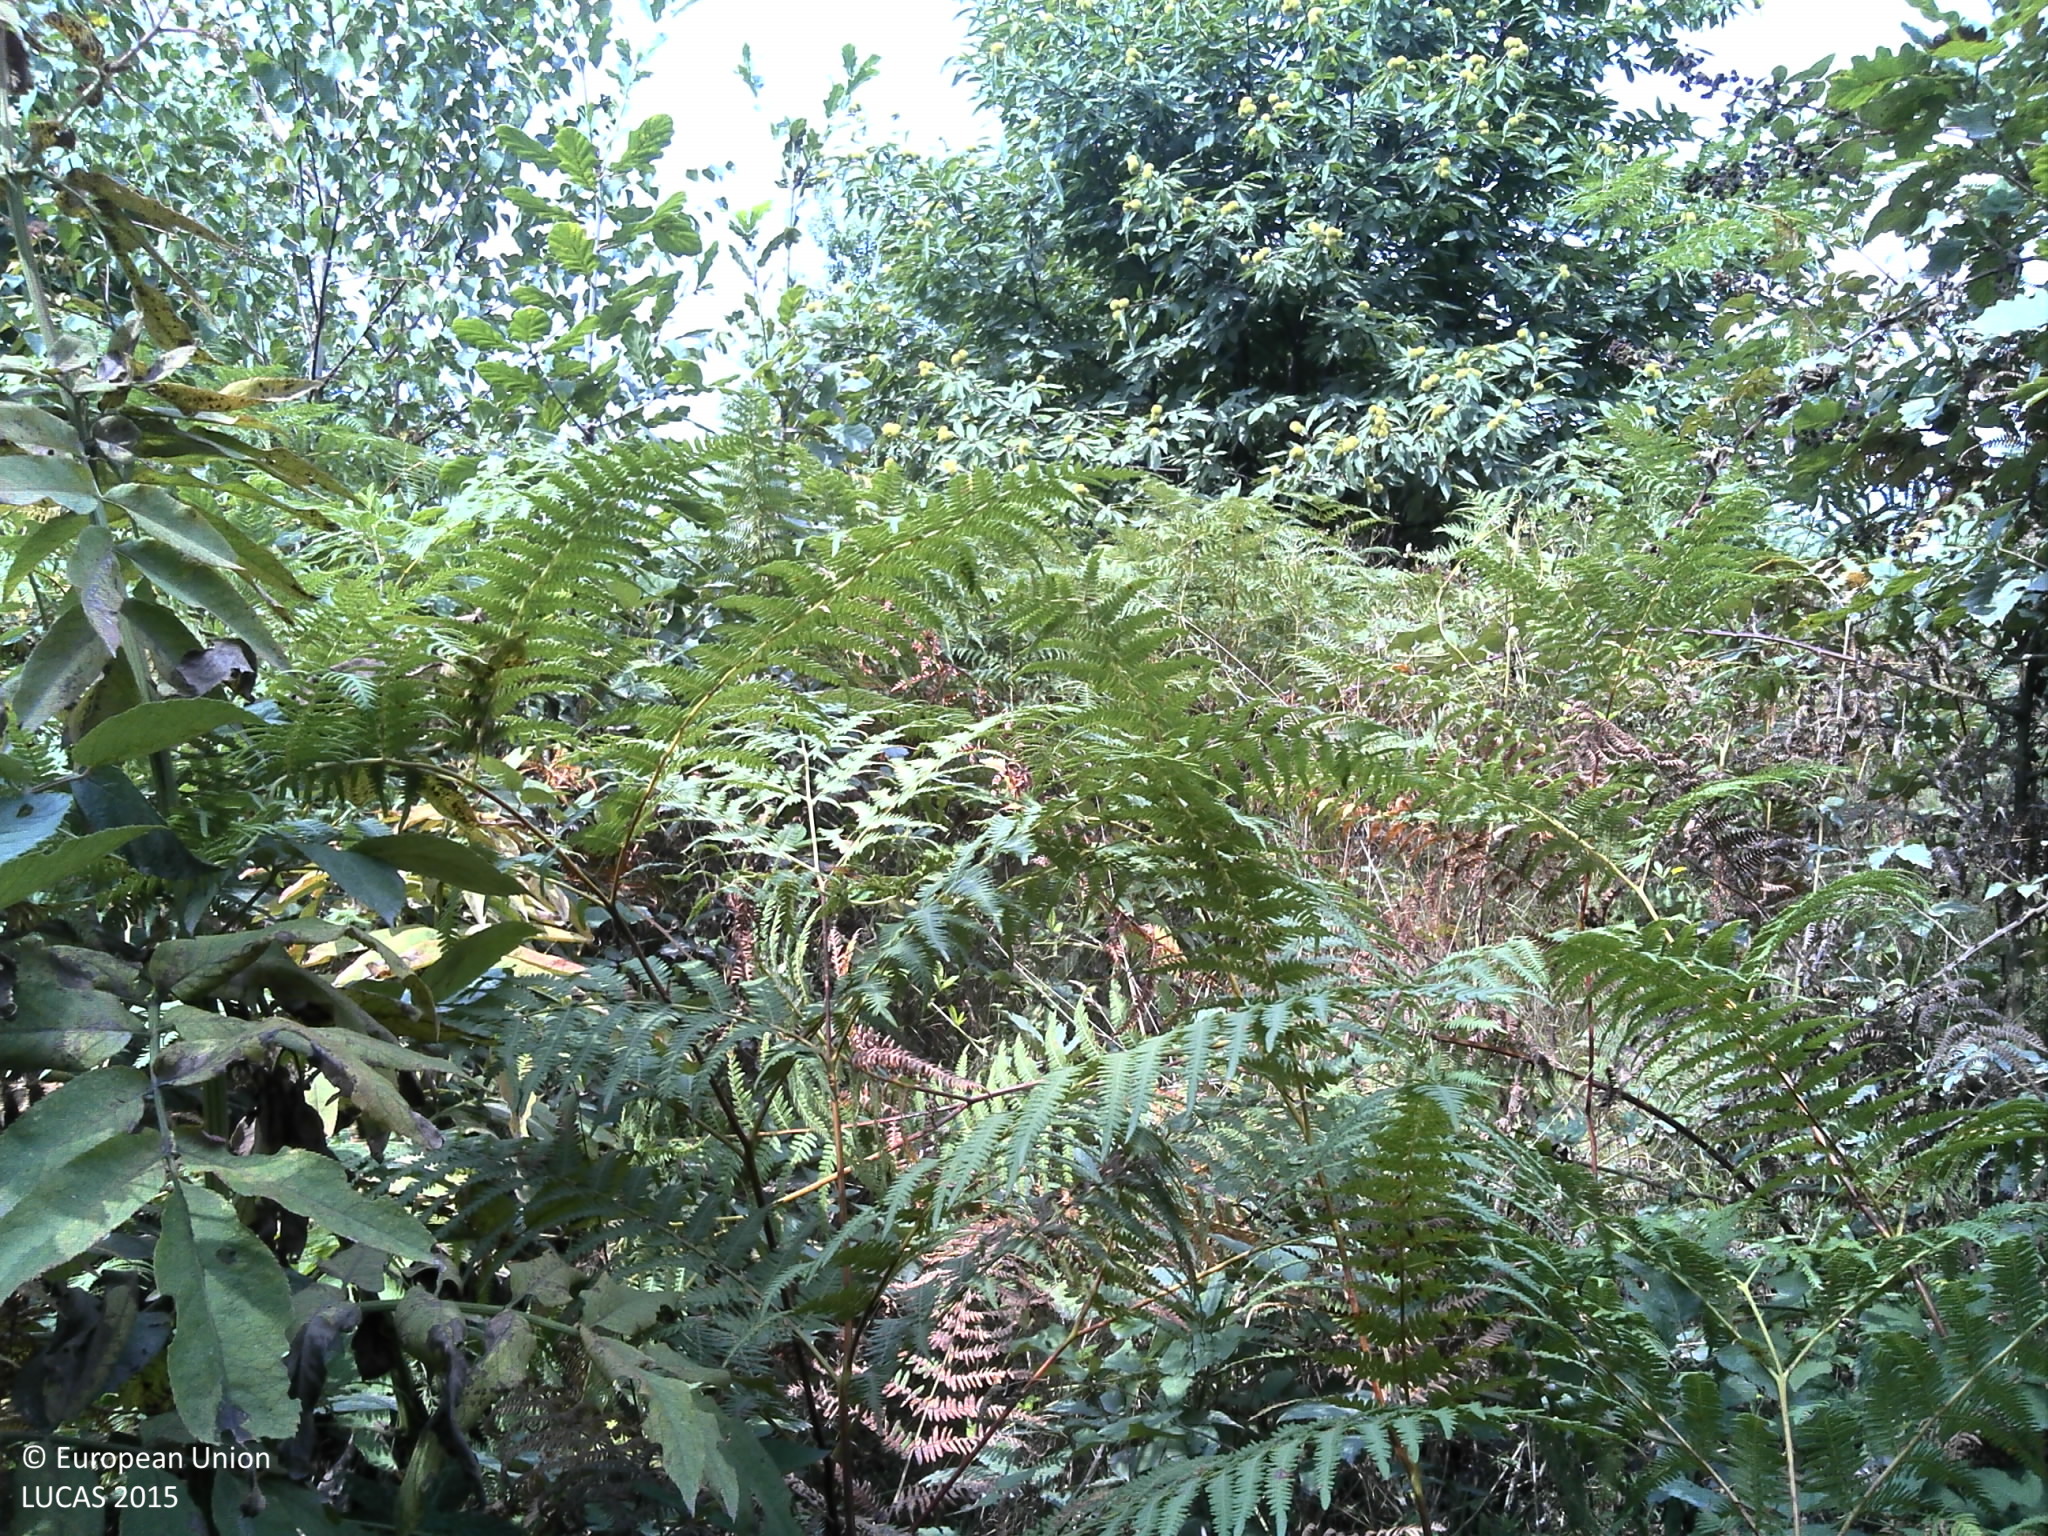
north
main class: Shrubland
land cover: Shrubland with sparse tree cover
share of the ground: > 75 %
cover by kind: shrubs 95 %, broadleaved forest trees 5 %
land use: Forestry
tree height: < 5 m
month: August
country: HR
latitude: 45.2227
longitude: 16.0456
